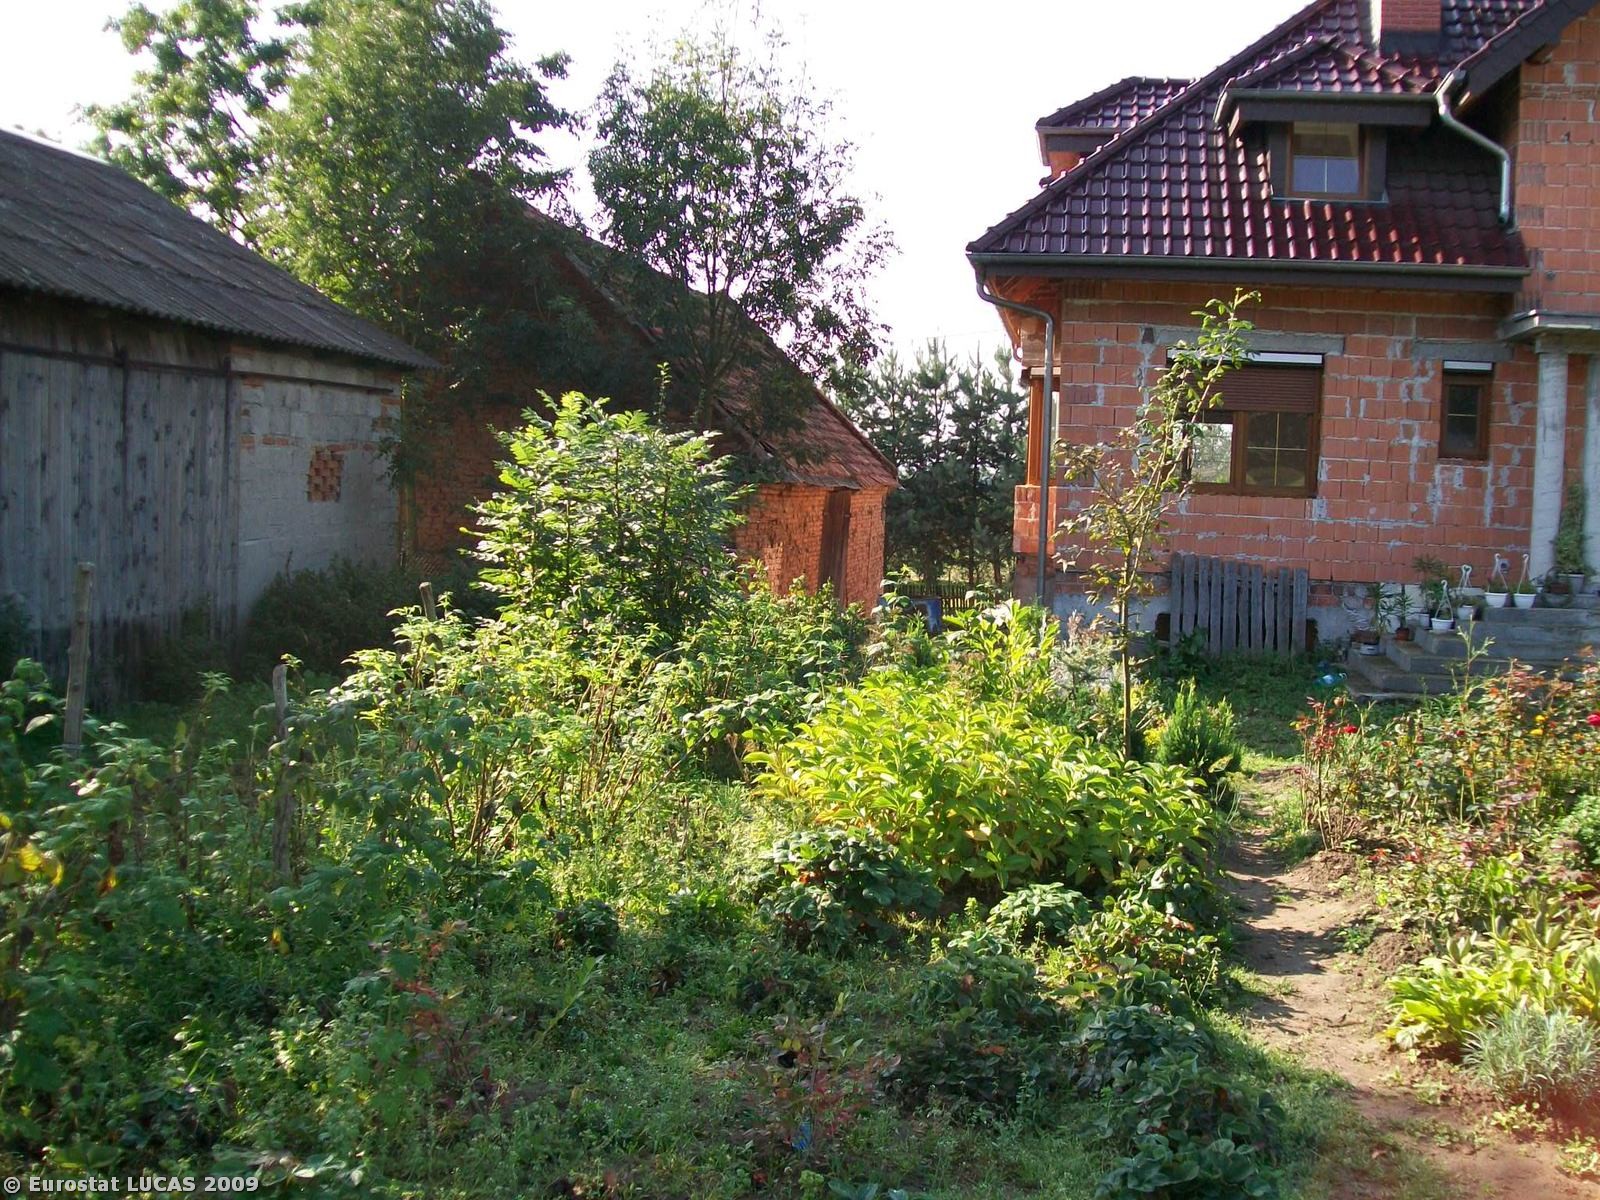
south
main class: Cropland
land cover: Strawberries
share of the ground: 25 - 50 %
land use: Kitchen garden
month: September
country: PL
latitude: 50.4614
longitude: 17.2094
